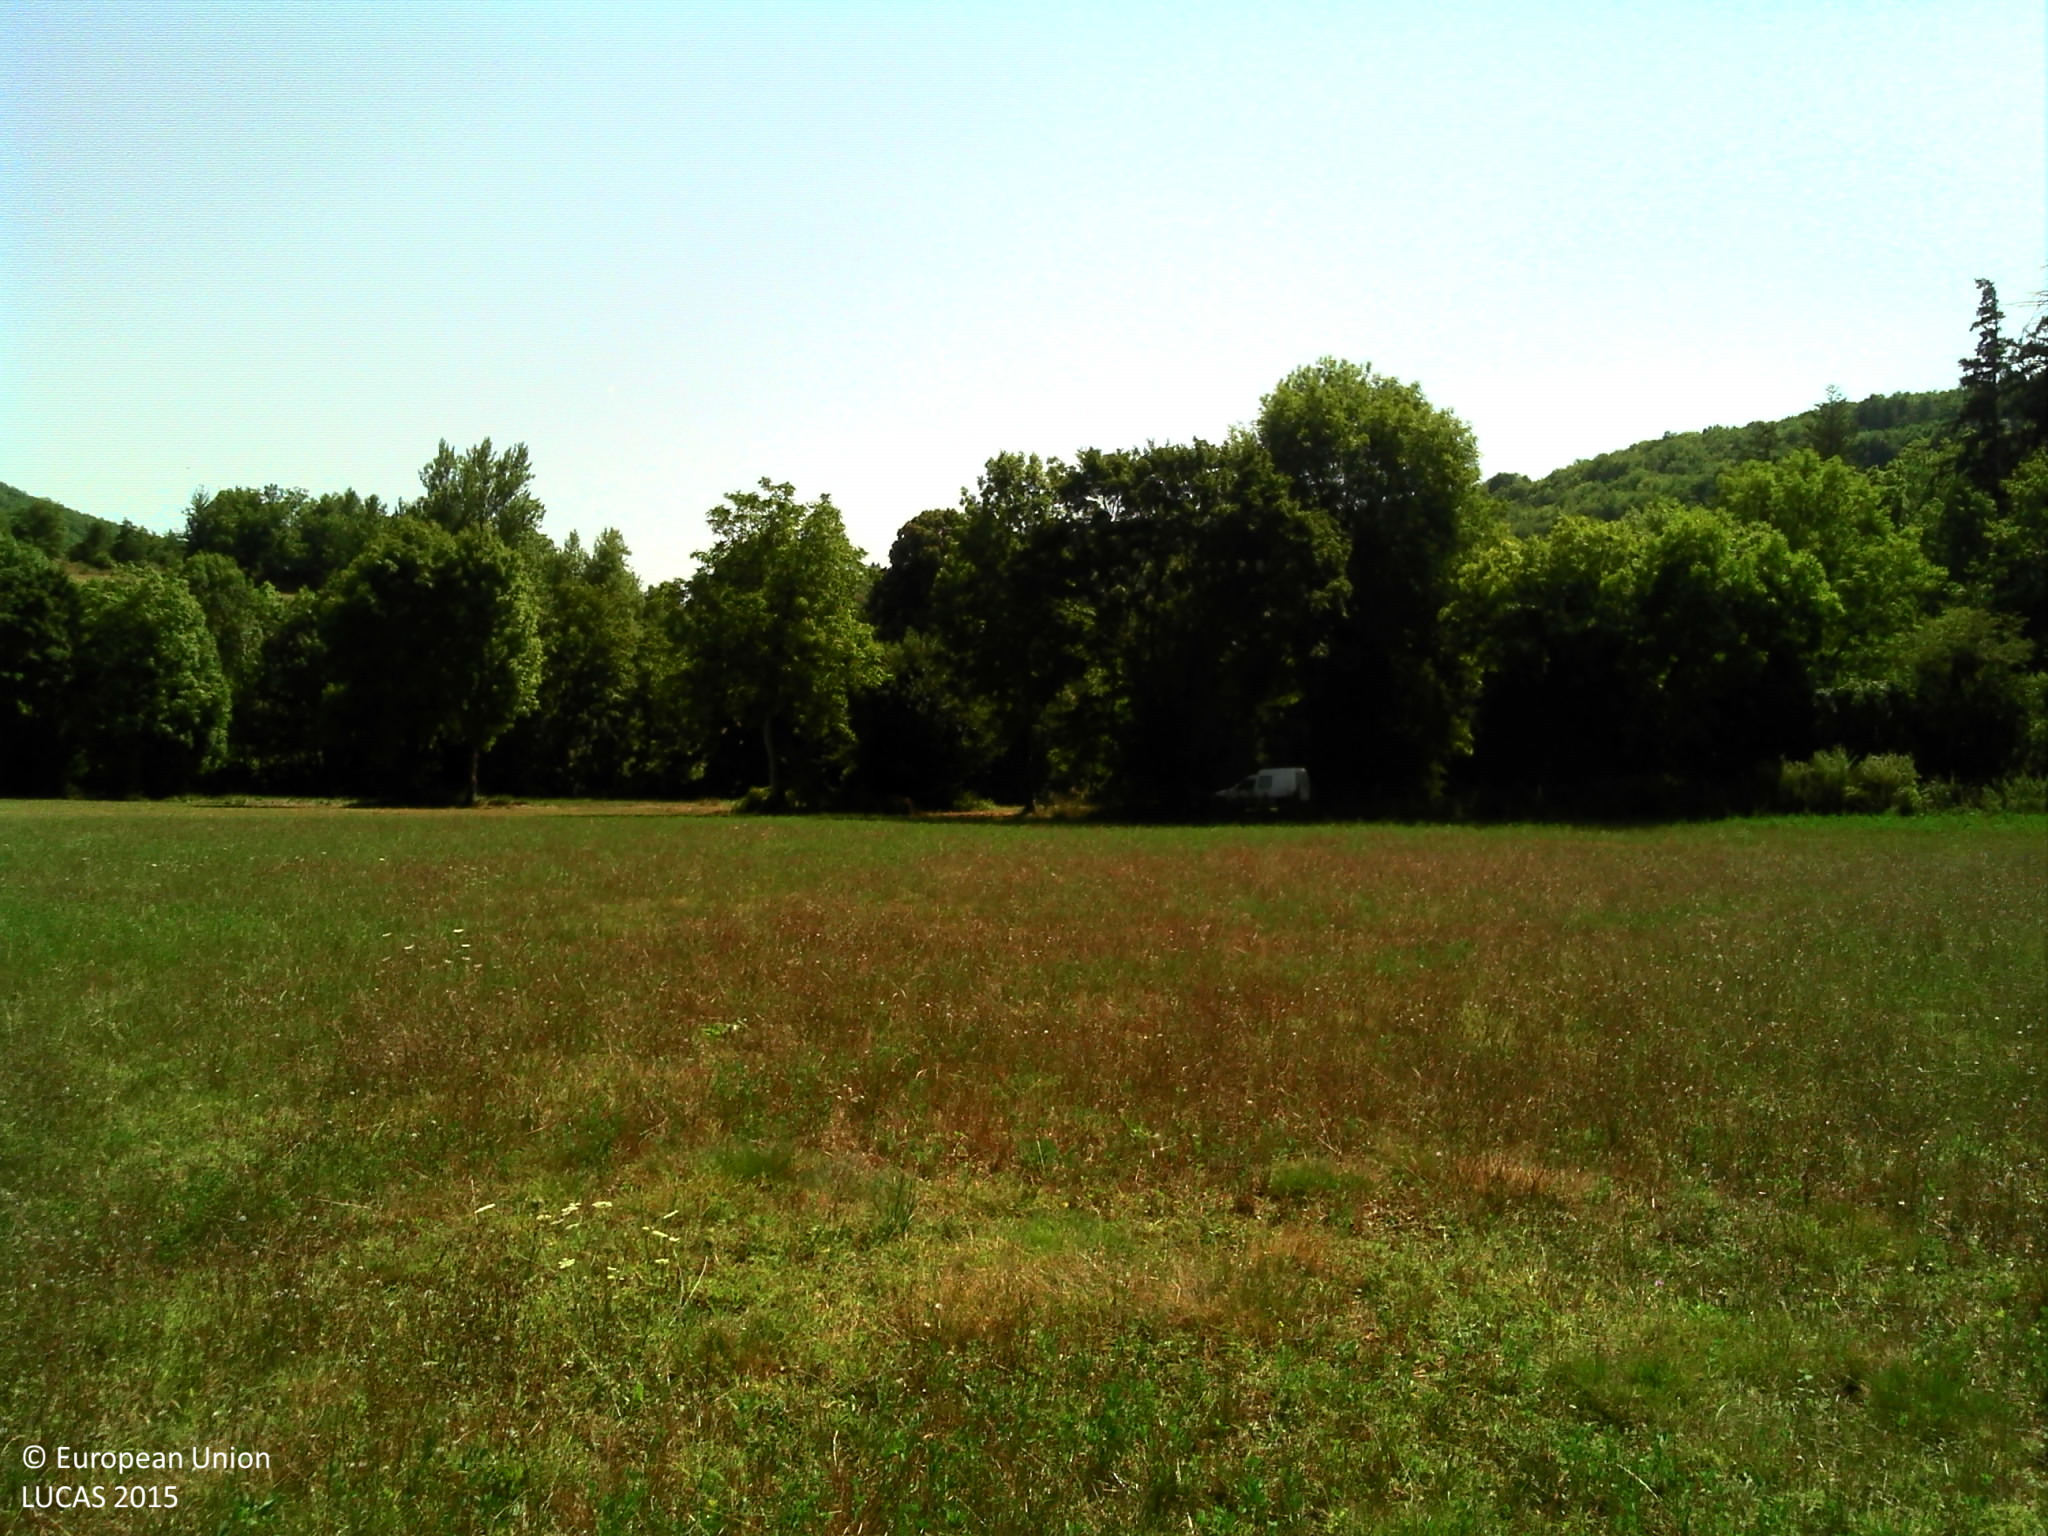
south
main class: Cropland
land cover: Temporary grasslands
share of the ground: > 75 %
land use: Agriculture (excluding fallow land and kitchen gardens)
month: August
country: FR
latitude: 43.8528
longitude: 2.6288
